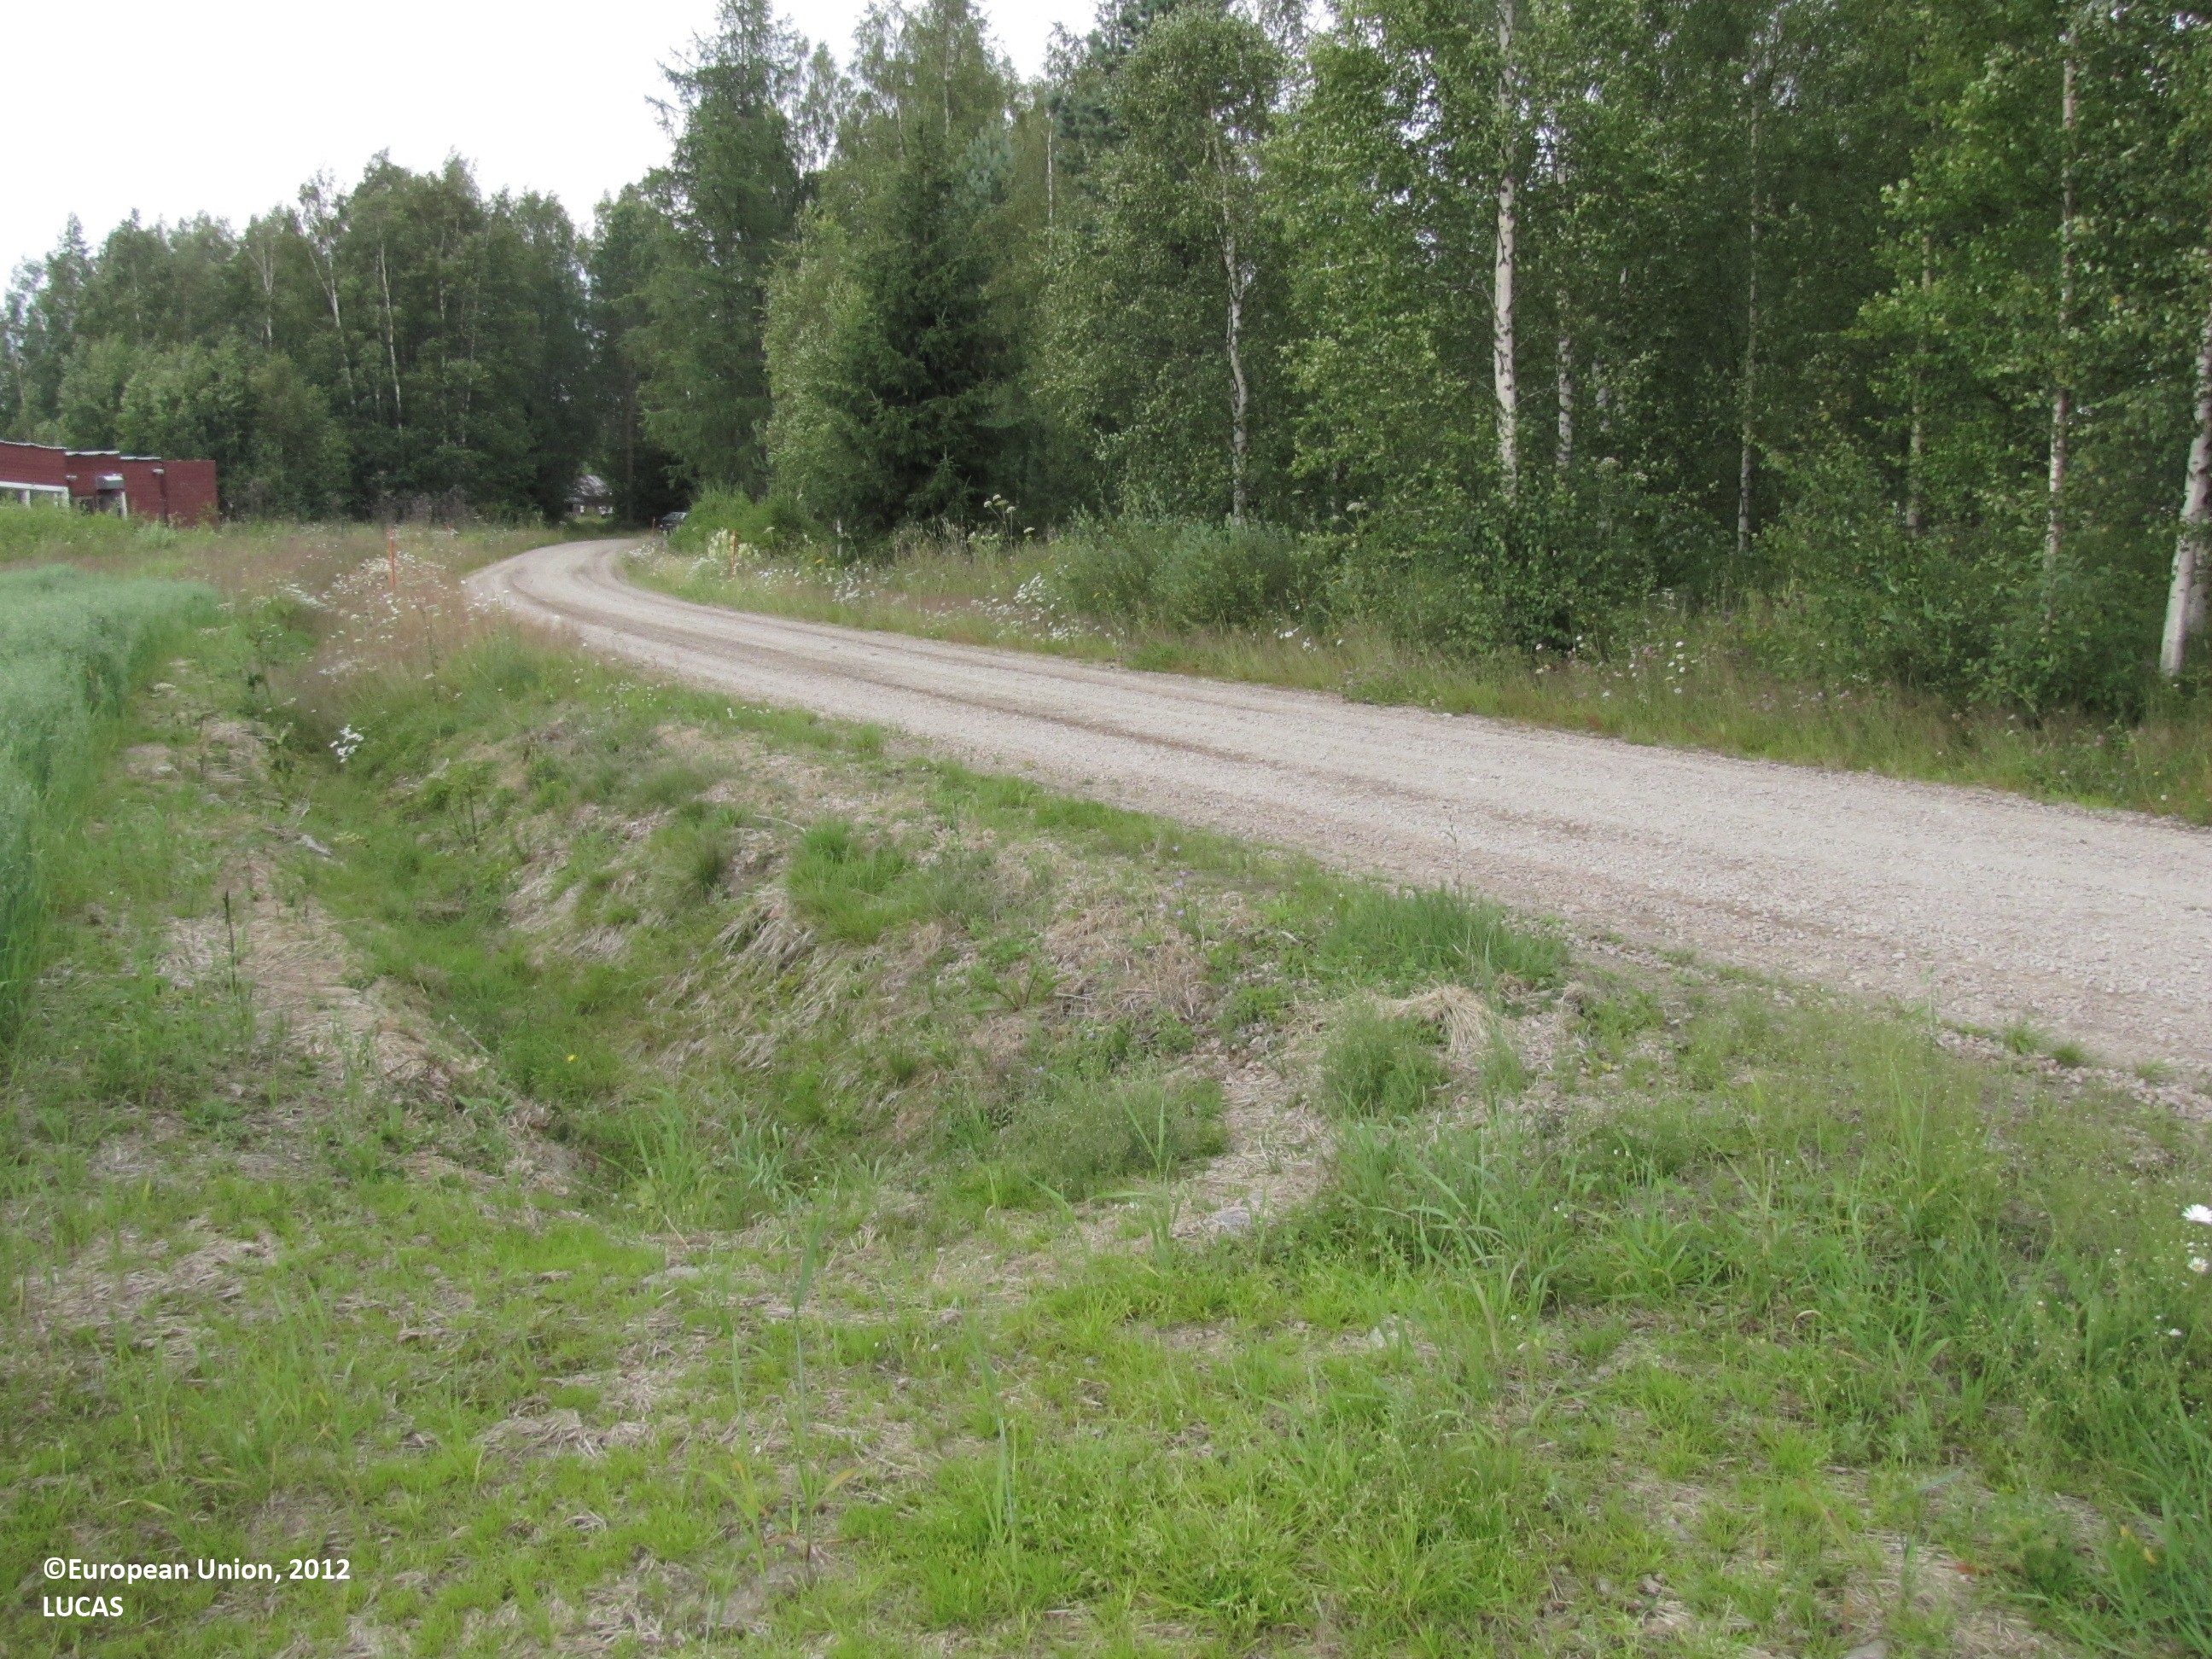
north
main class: Cropland
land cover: Oats
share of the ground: > 75 %
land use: Agriculture (excluding fallow land and kitchen gardens)
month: July
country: FI
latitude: 61.9950
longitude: 22.9526
